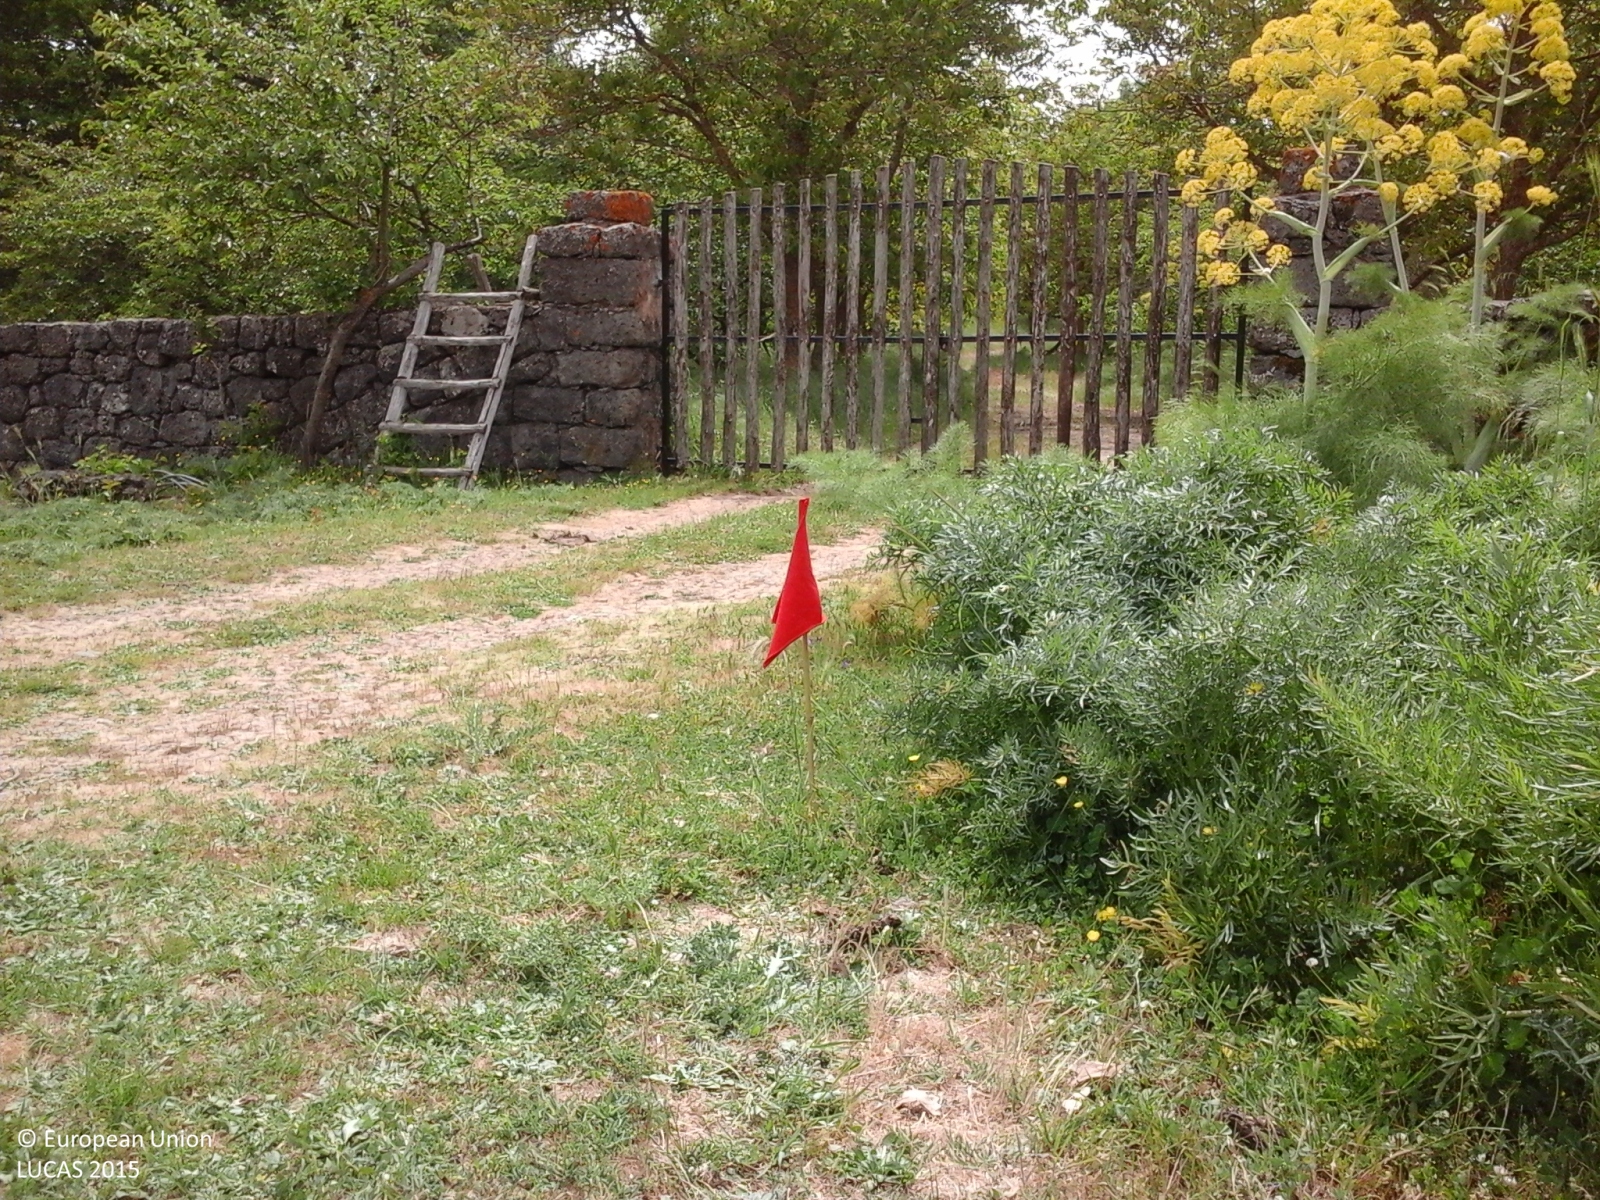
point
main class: Grassland
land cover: Grassland without tree/shrub cover
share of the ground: > 75 %
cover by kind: herbaceous plants 100 %
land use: Agriculture (excluding fallow land and kitchen gardens)
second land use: Amenities, museums, leisure
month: May
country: IT
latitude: 37.8581
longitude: 14.8880
